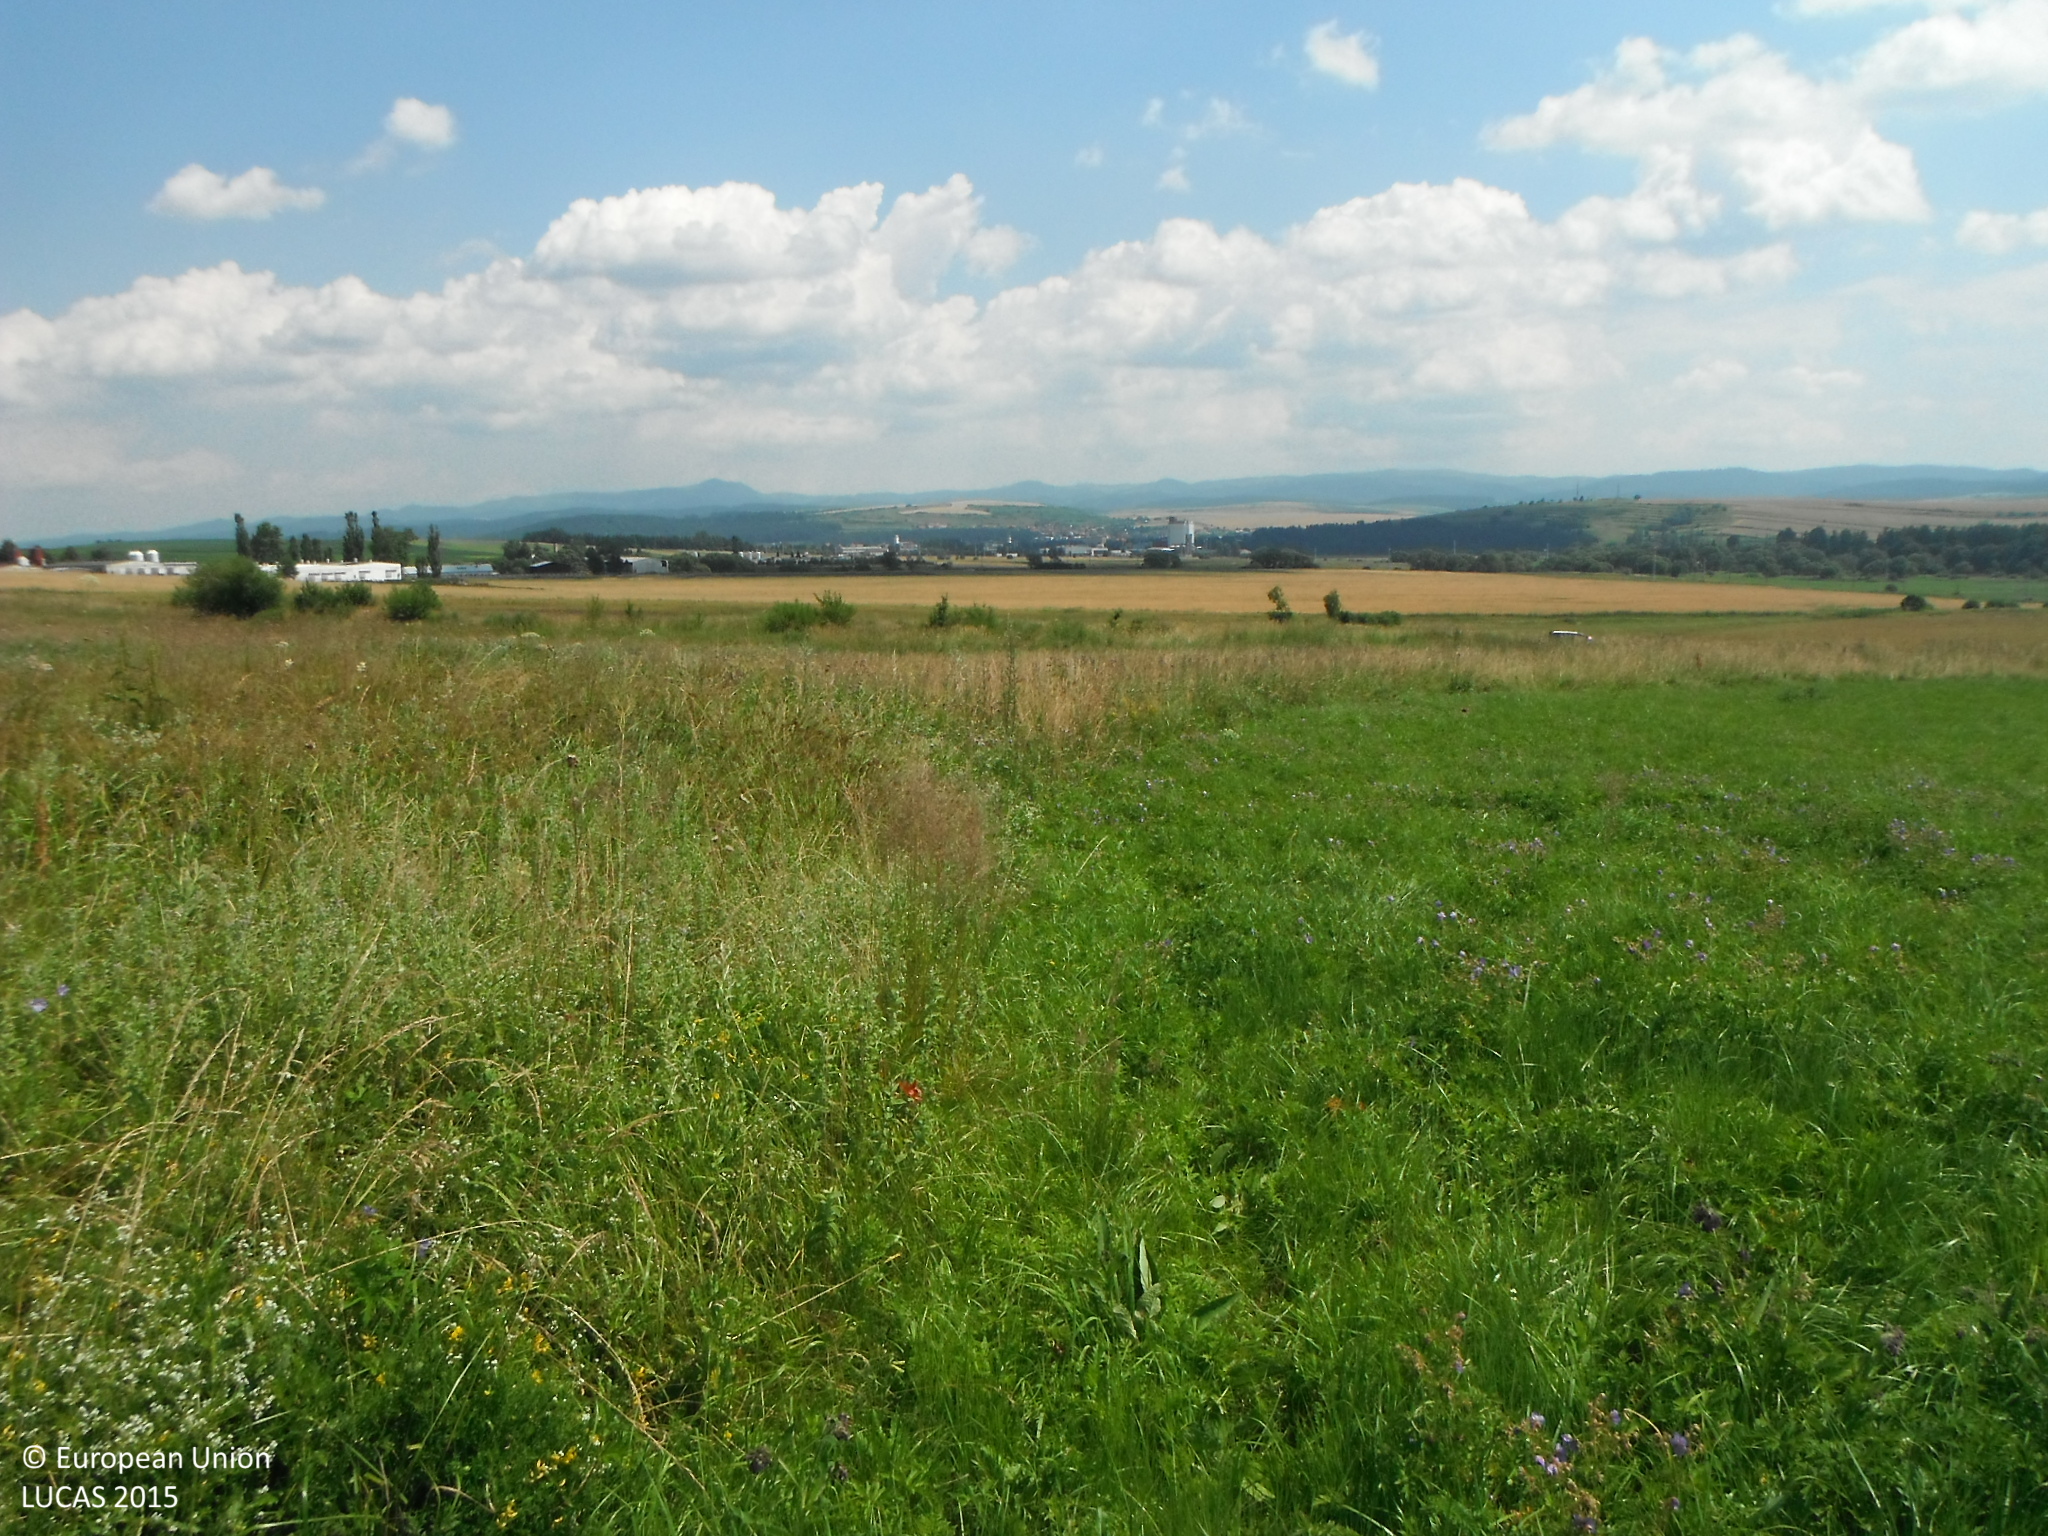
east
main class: Grassland
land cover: Grassland without tree/shrub cover
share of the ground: > 75 %
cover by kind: herbaceous plants 100 %
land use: Agriculture (excluding fallow land and kitchen gardens)
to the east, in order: Grassland without tree/shrub cover; Spontaneously vegetated surfaces; Tracks; Spontaneously vegetated surfaces; Other fibre and oleaginous crops
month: July
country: SK
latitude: 49.1287
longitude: 20.3817
